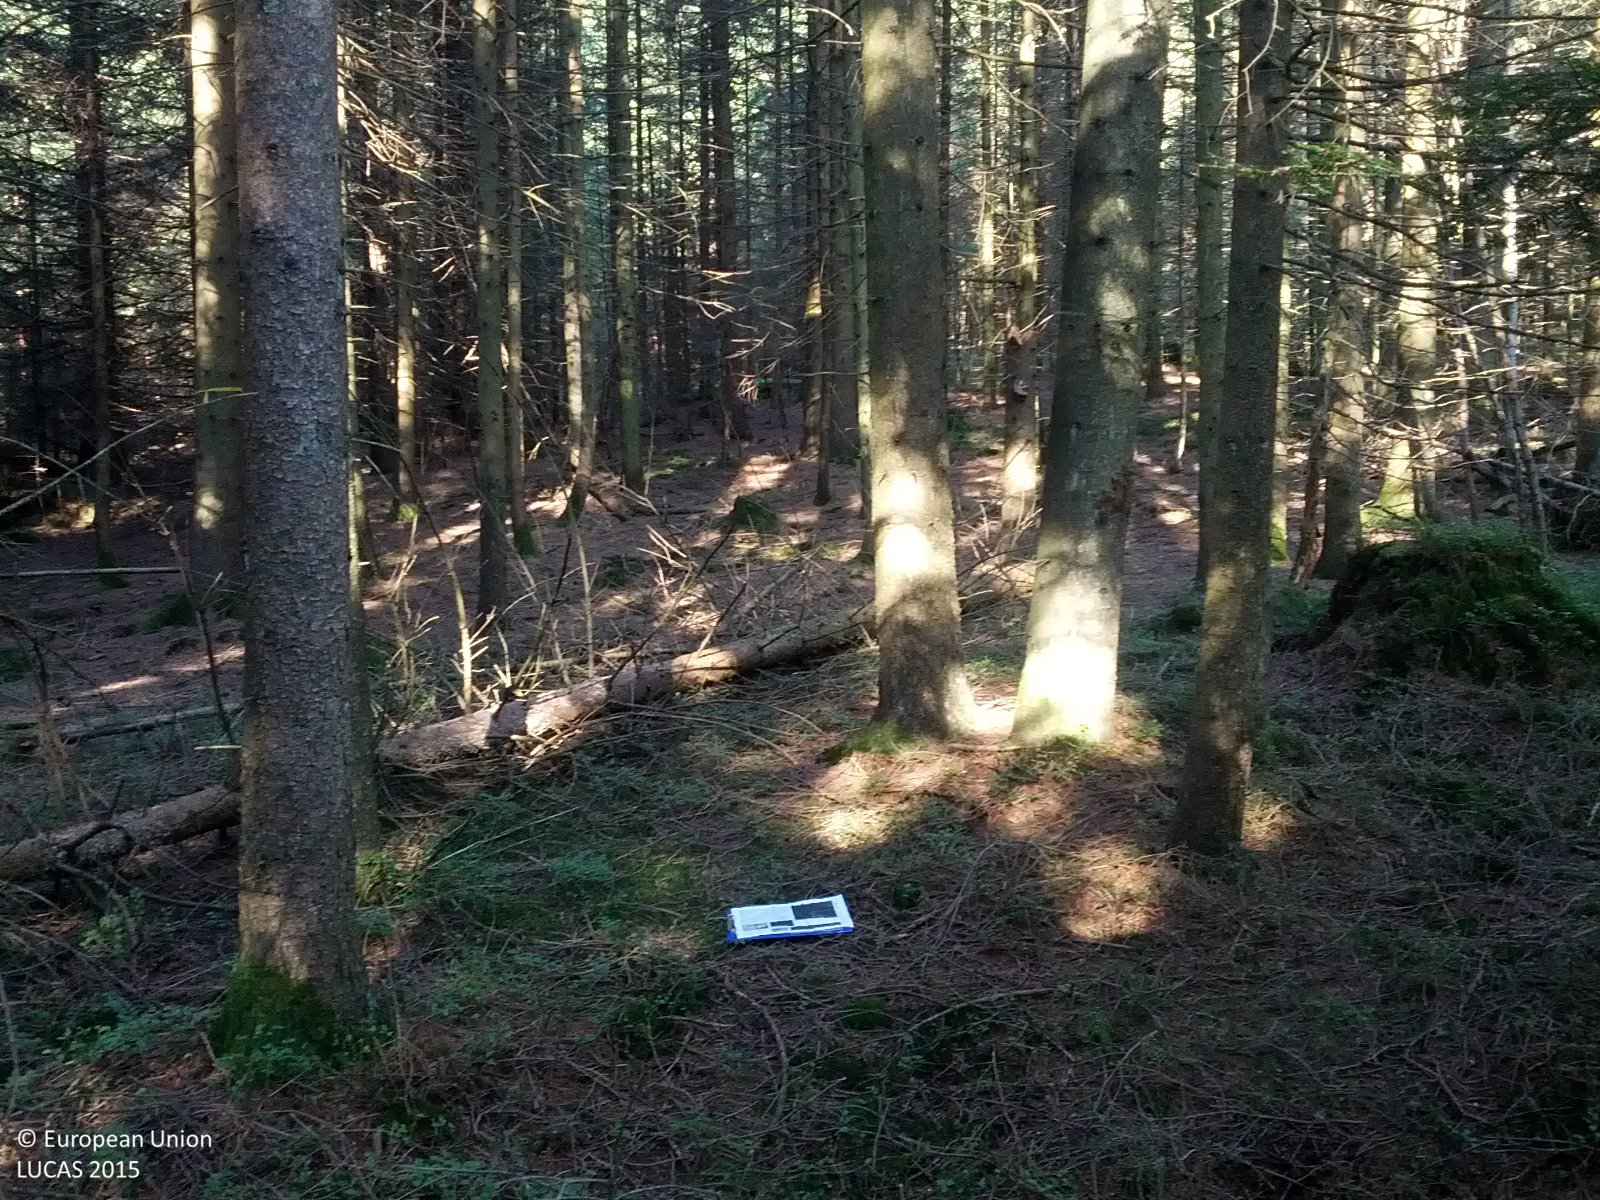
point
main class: Woodland
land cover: Spruce dominated coniferous woodland
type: alpine coniferous forest
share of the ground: > 75 %
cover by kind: coniferous forest trees 95 %, lichens and mosses 5 %
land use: Forestry
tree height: > 5 m
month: September
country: AT
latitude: 48.0281
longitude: 13.3649
